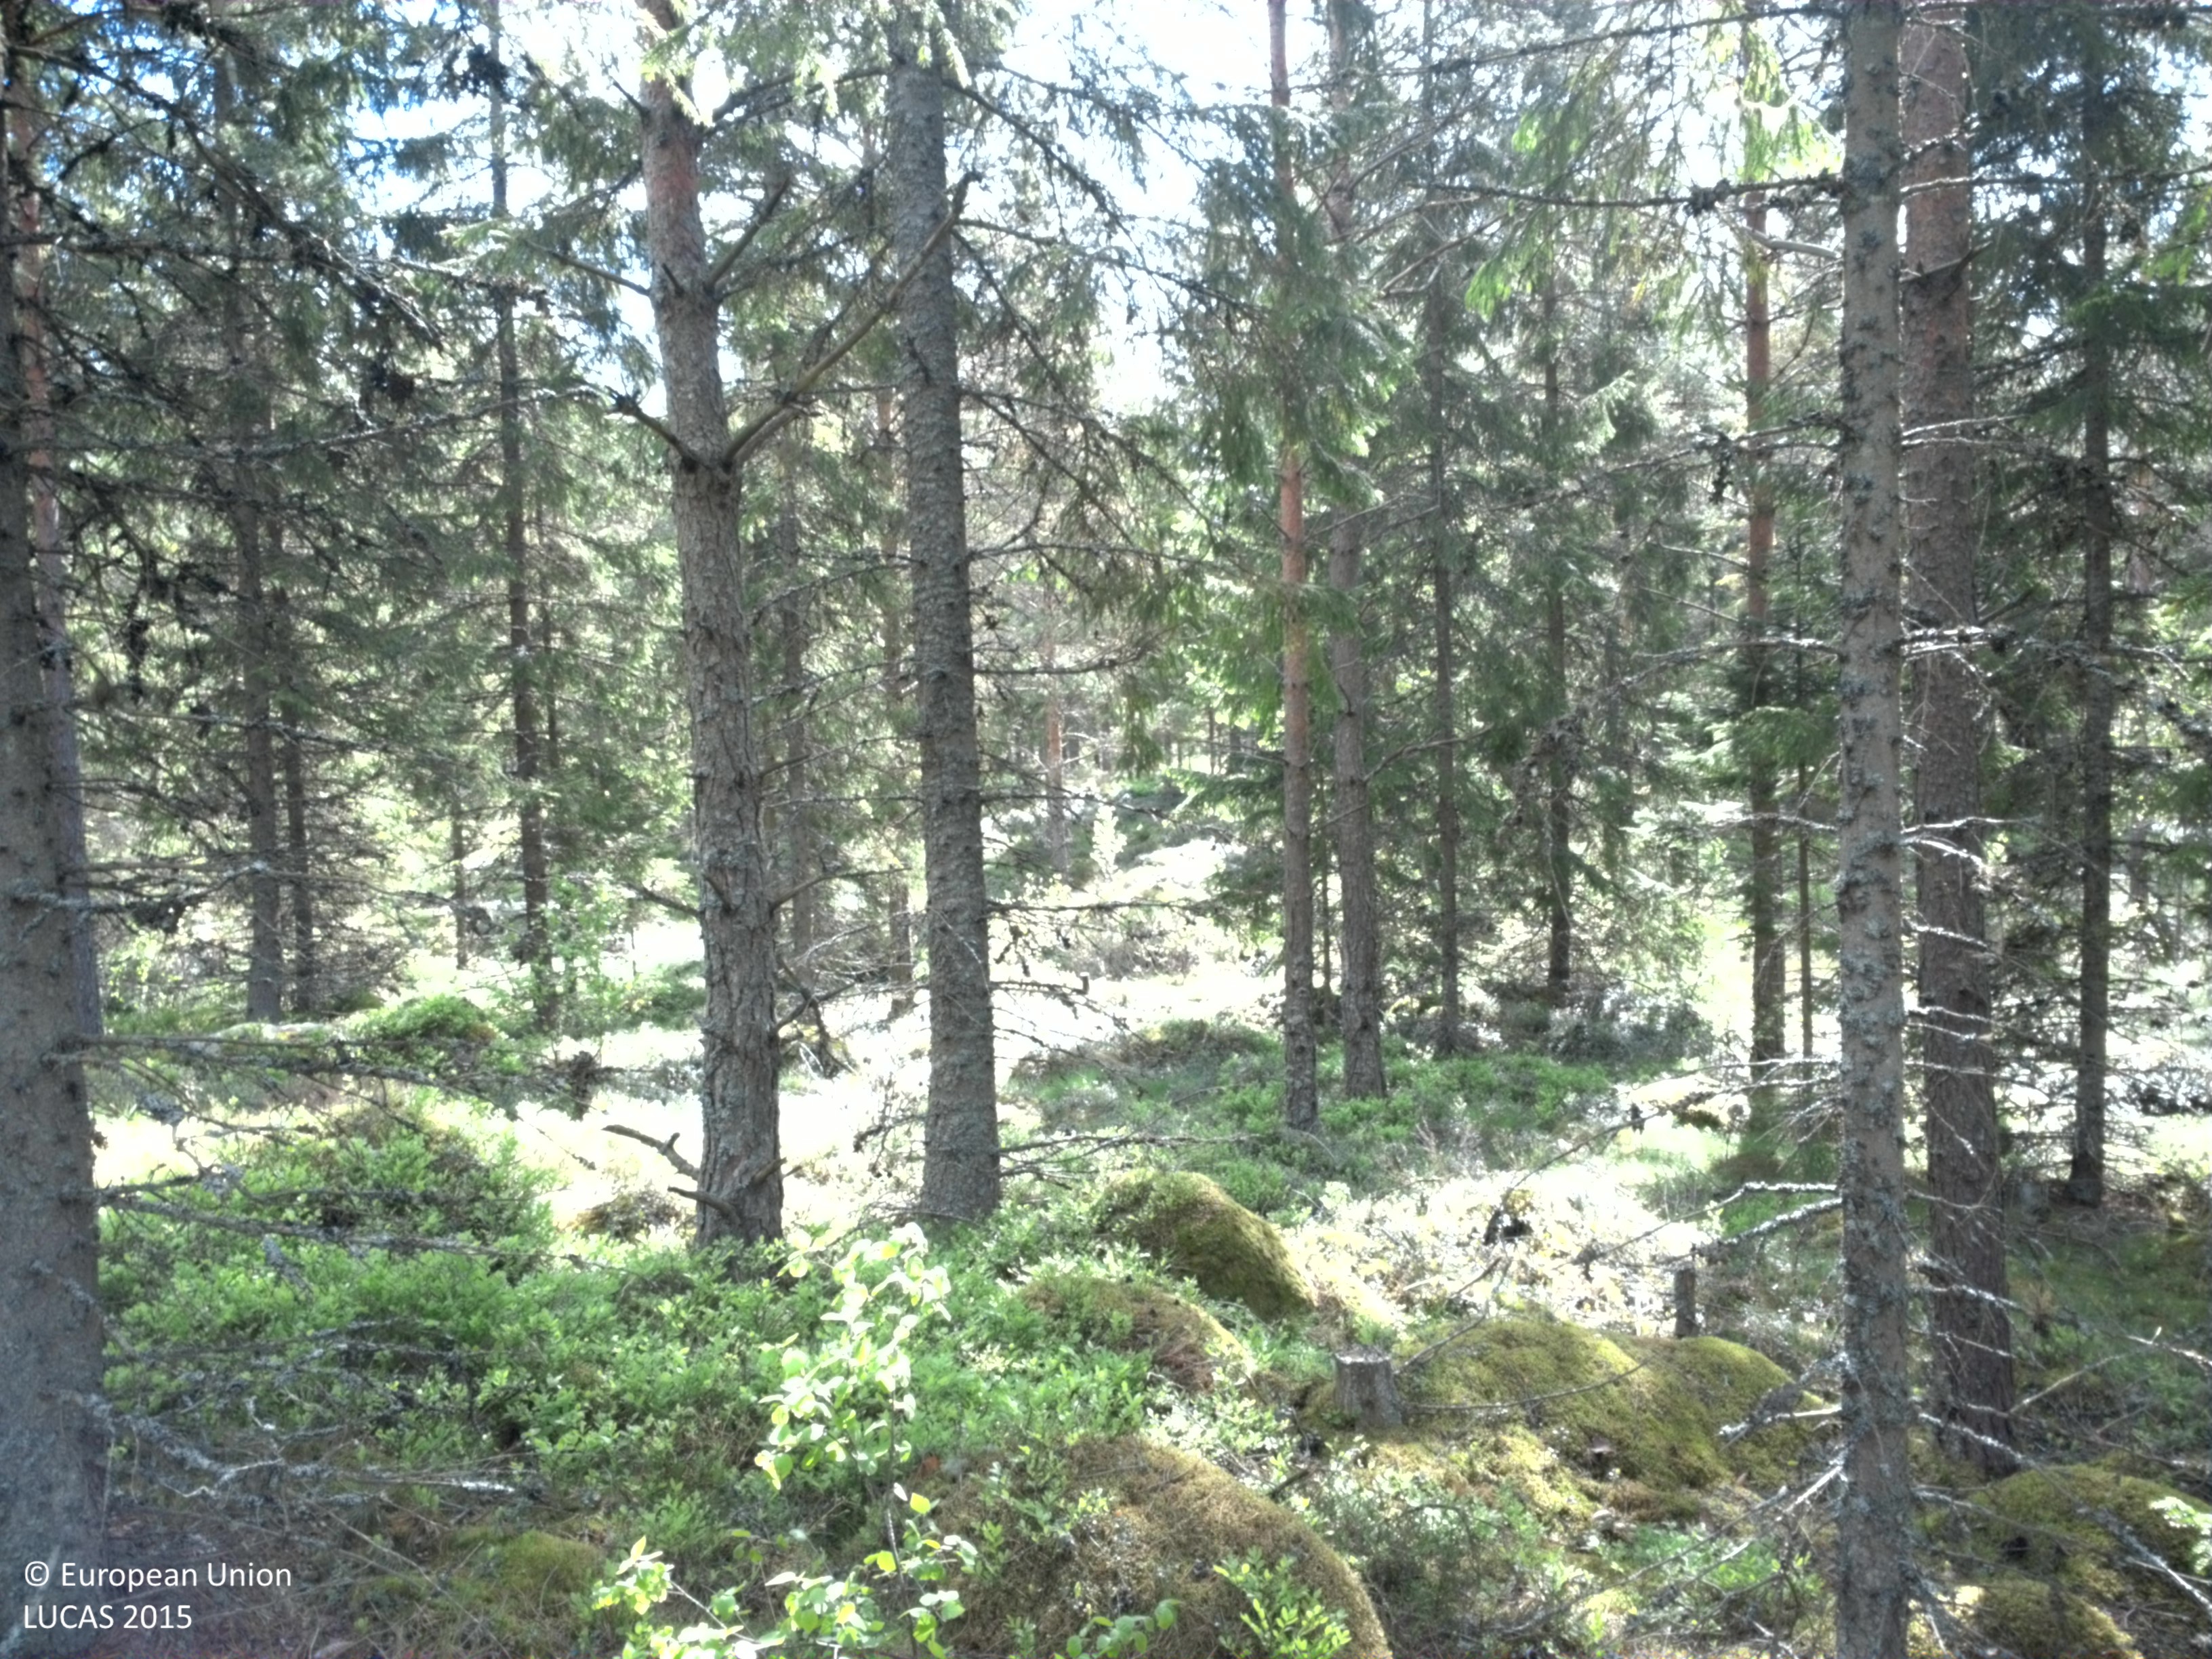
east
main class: Woodland
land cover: Spruce dominated coniferous woodland
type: boreal forest
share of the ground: 50 - 75 %
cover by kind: coniferous forest trees 50 %, shrubs 20 %, lichens and mosses 20 %, herbaceous plants 10 %
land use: Forestry
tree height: > 5 m
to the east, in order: Spruce dominated coniferous woodland; Tracks; Pine dominated coniferous woodland; Spruce dominated coniferous woodland; Spruce dominated mixed woodland; Spruce dominated coniferous woodland; Tracks; Spruce dominated coniferous woodland
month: June
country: SE
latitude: 56.7809
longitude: 14.3340
